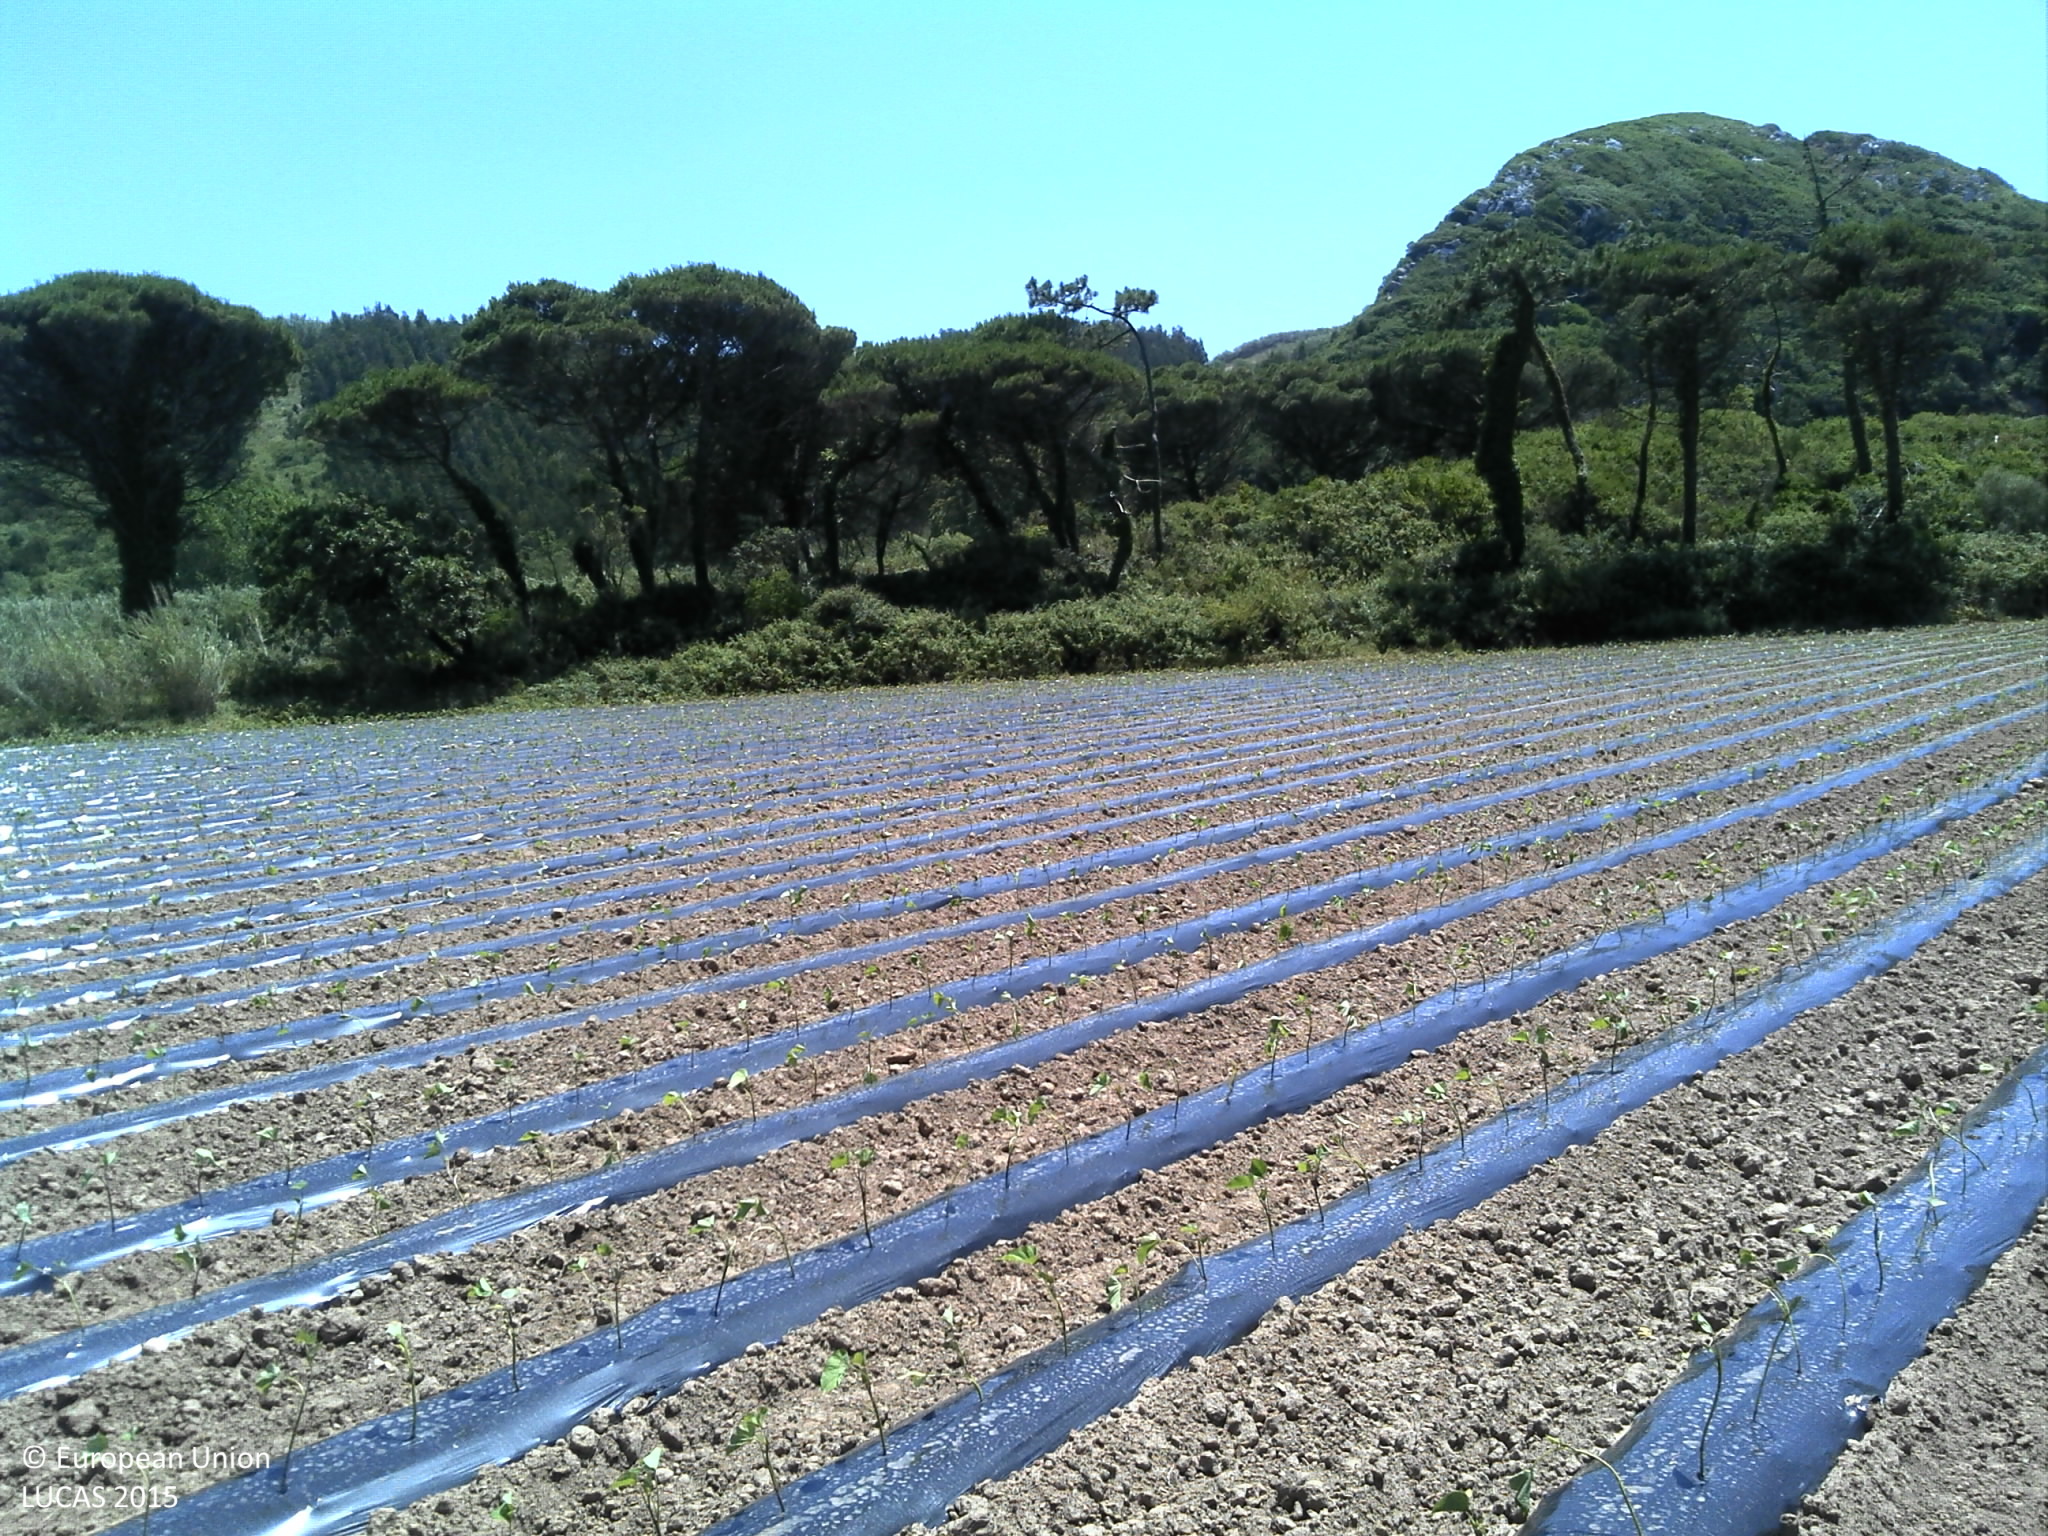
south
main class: Cropland
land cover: Other root crops
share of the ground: 10 - 25 %
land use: Agriculture (excluding fallow land and kitchen gardens)
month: June
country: PT
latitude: 39.1750
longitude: -9.3401
